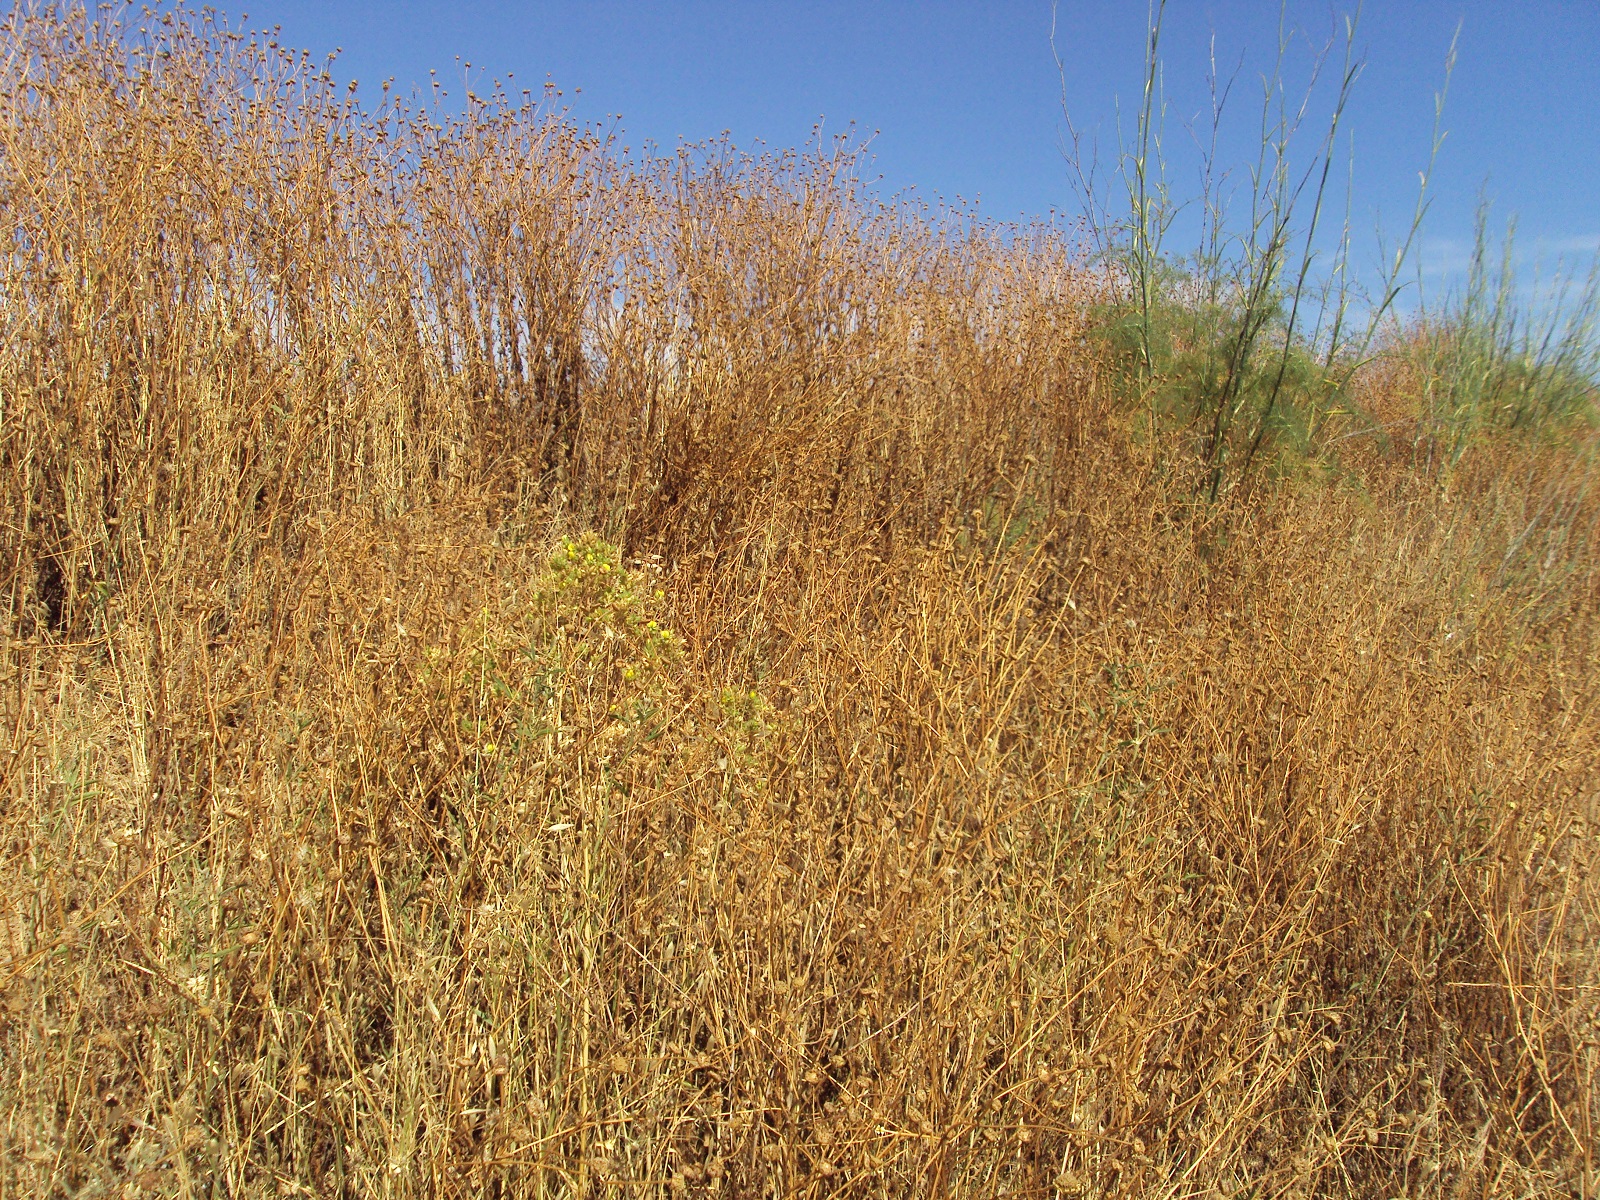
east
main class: Cropland
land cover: Dry pulses
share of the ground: > 75 %
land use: Agriculture (excluding fallow land and kitchen gardens)
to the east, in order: Grass margins; Dry pulses; Spontaneously vegetated surfaces; Sunflower
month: June
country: ES
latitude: 37.3787
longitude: -6.5323
